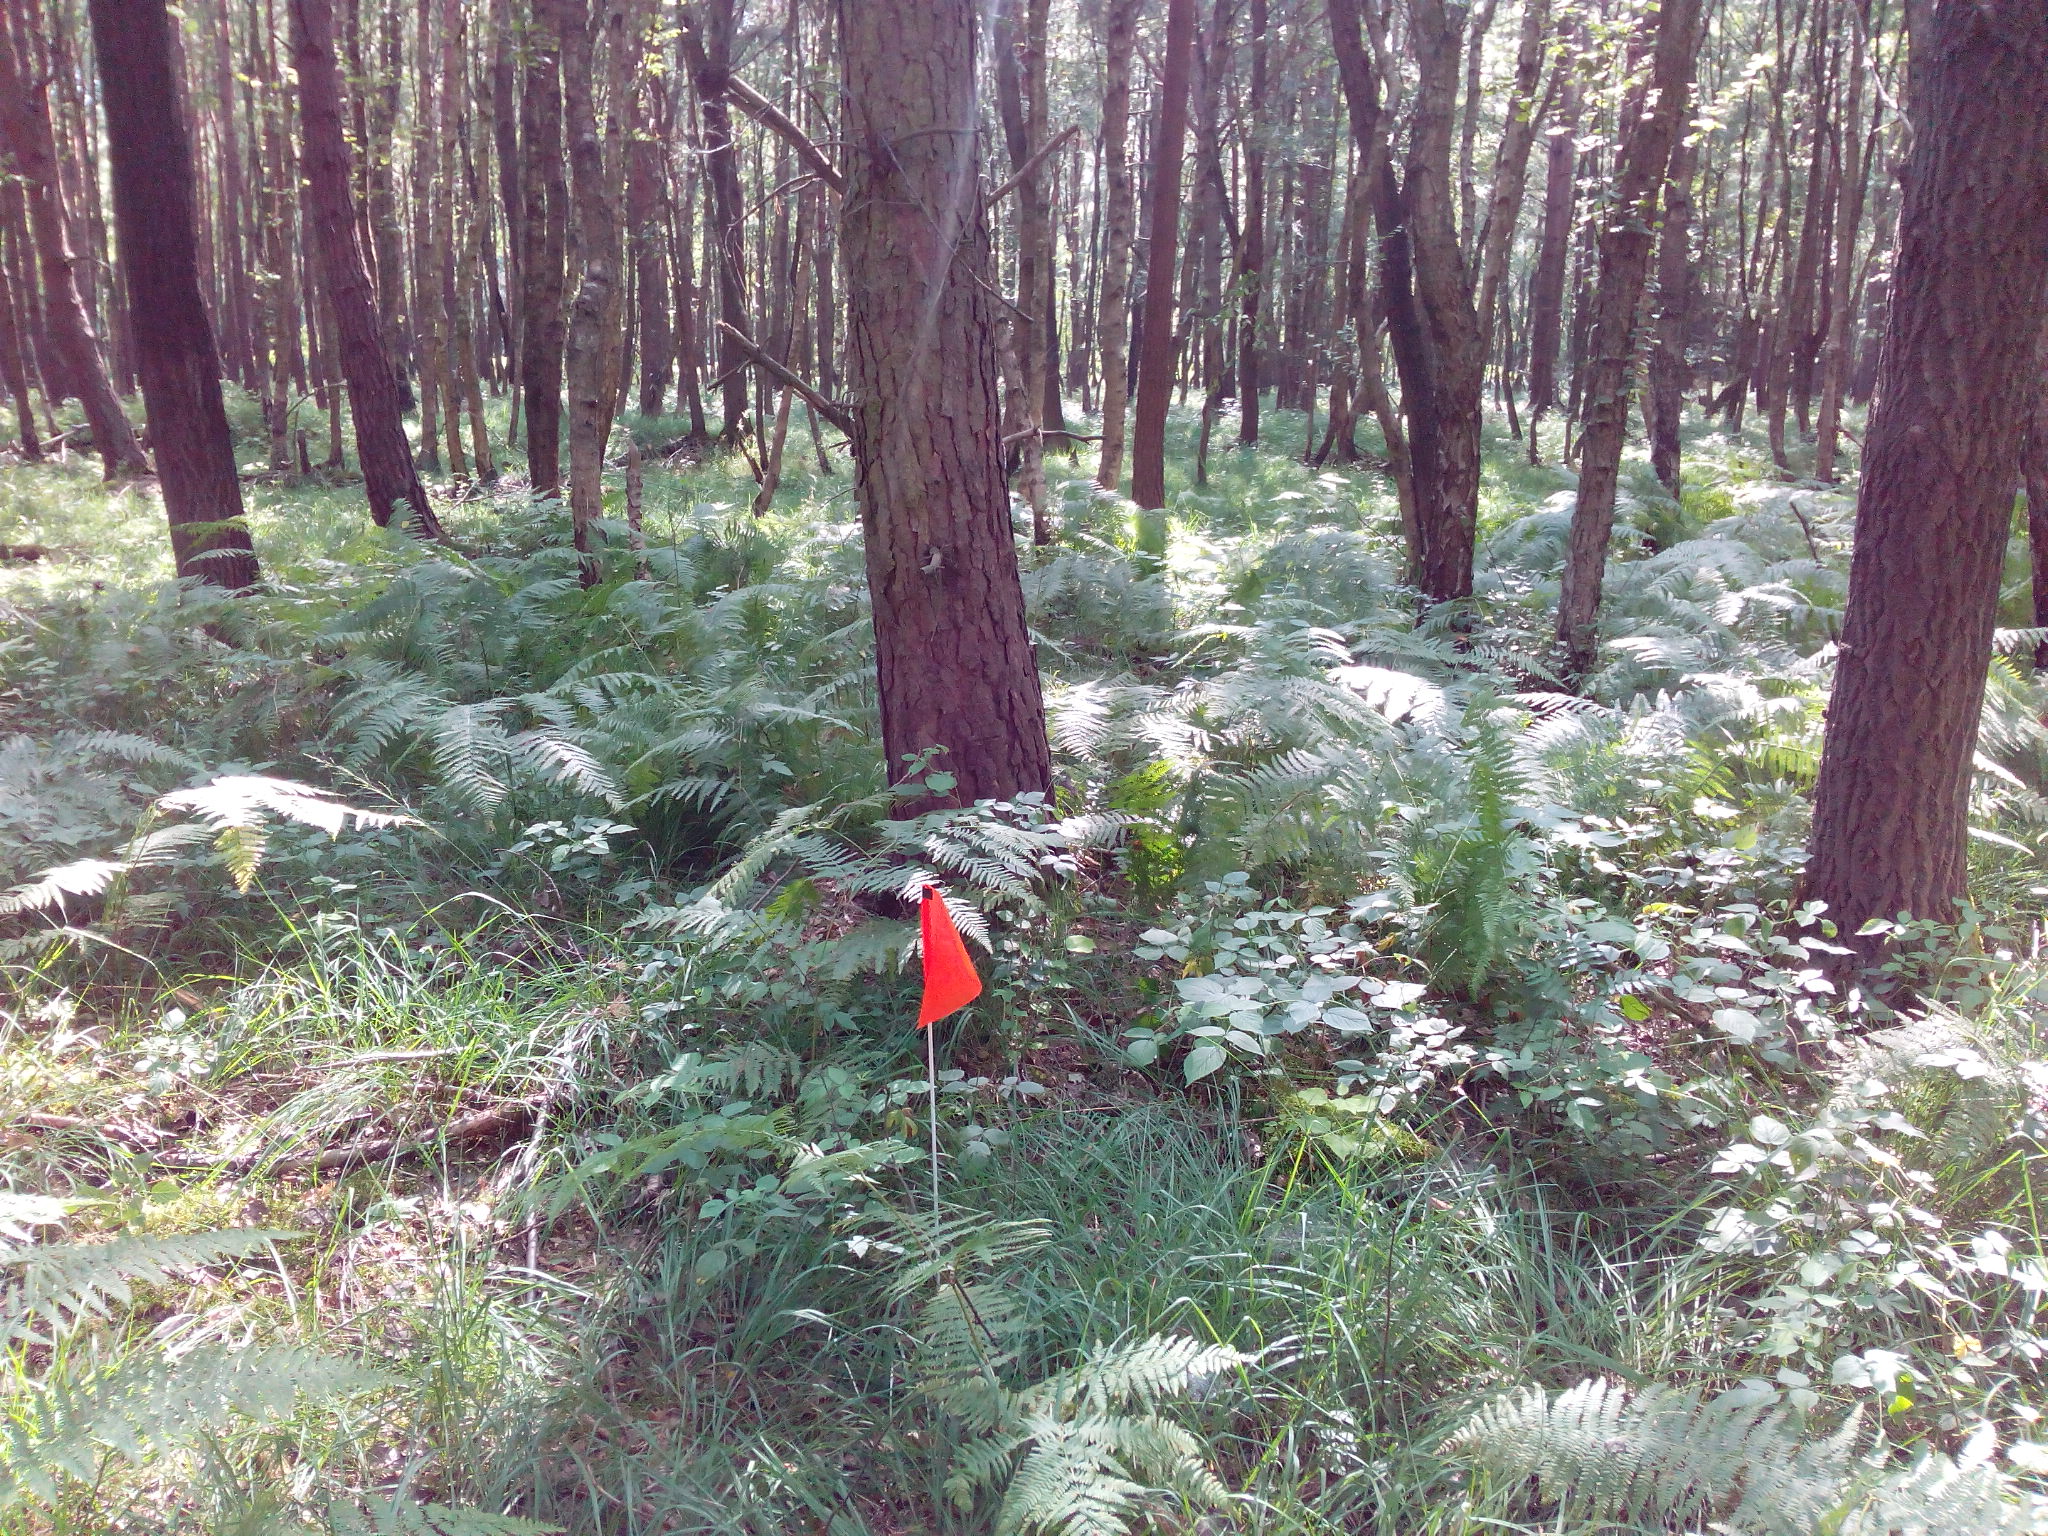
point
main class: Woodland
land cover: Pine dominated mixed woodland
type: hemiboreal forest and nemoral coniferous forest and mixed broadleaved-coniferous forest
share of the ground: > 75 %
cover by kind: broadleaved forest trees 50 %, coniferous forest trees 45 %, herbaceous plants 5 %
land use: Forestry
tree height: > 5 m
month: August
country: DE
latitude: 52.4134
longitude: 9.9265
